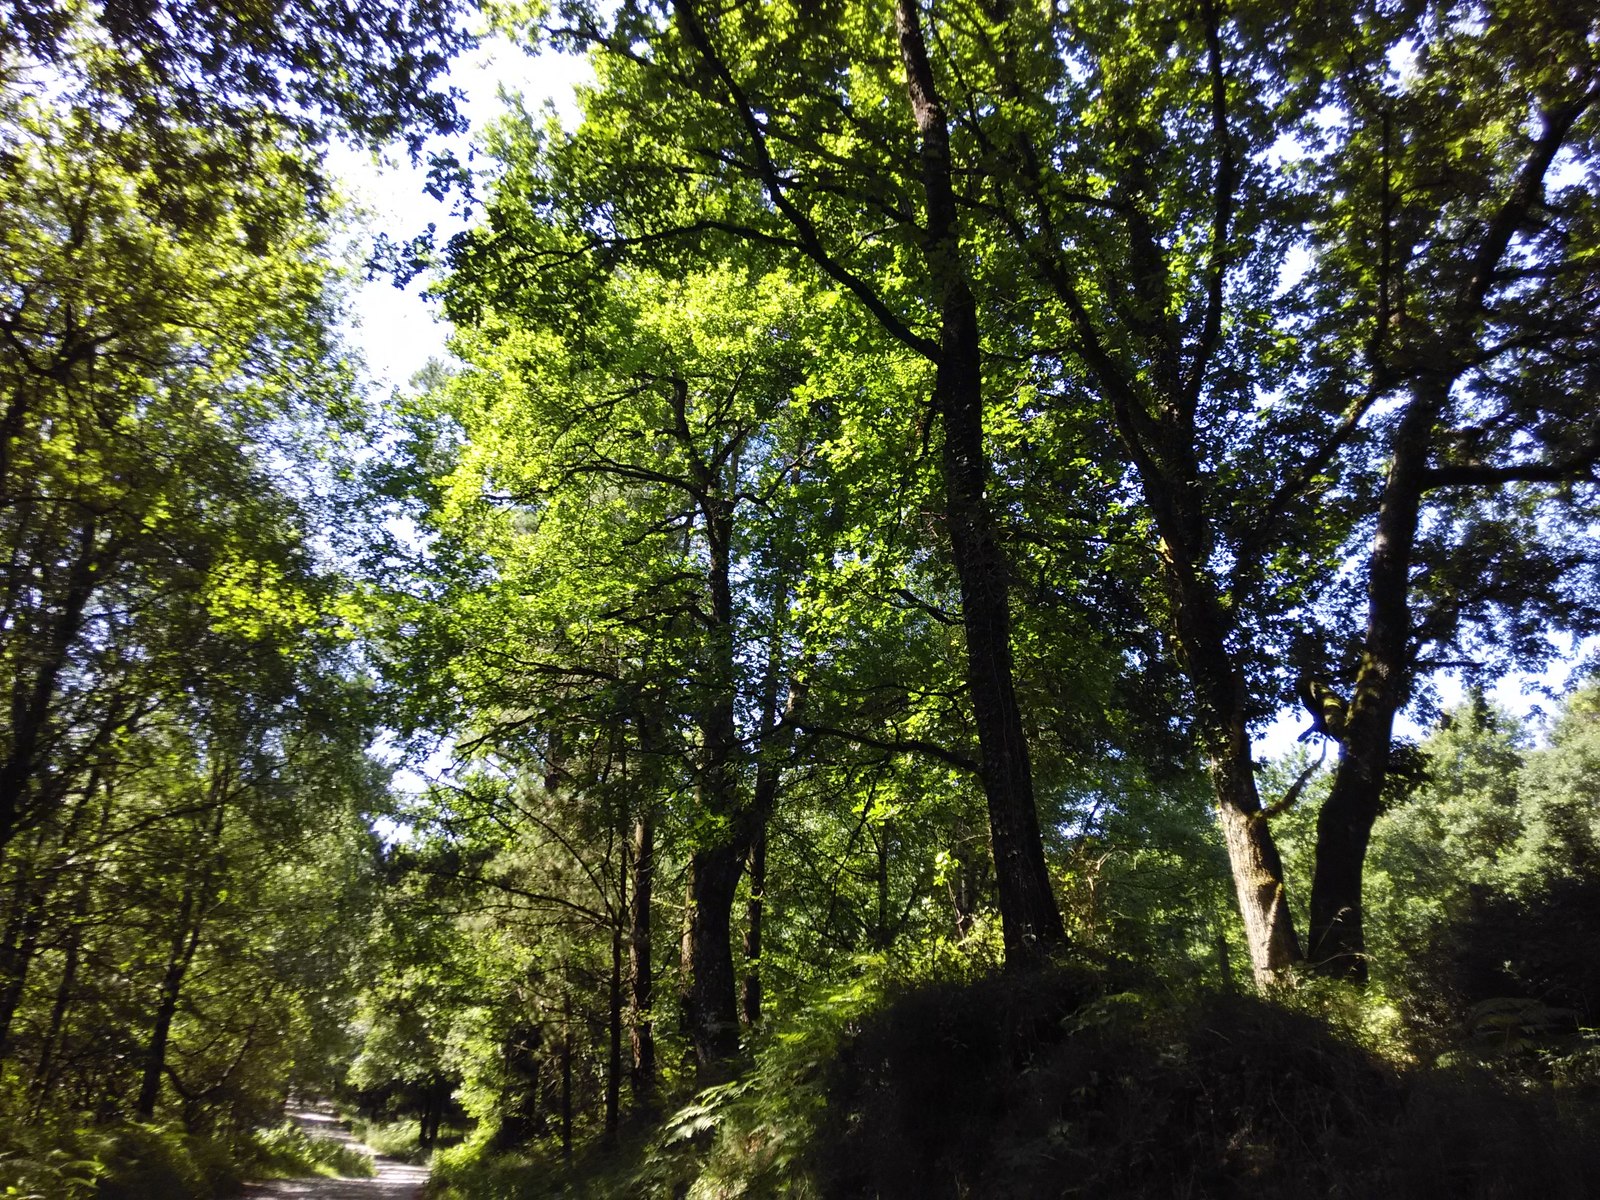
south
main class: Woodland
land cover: Broadleaved woodland
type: acidophilous oak and oak-birch forest
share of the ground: > 75 %
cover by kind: broadleaved forest trees 90 %, unconsolidated bare surface 10 %
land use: Forestry
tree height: > 5 m
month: July
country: ES
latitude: 43.0044
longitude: -2.2290
